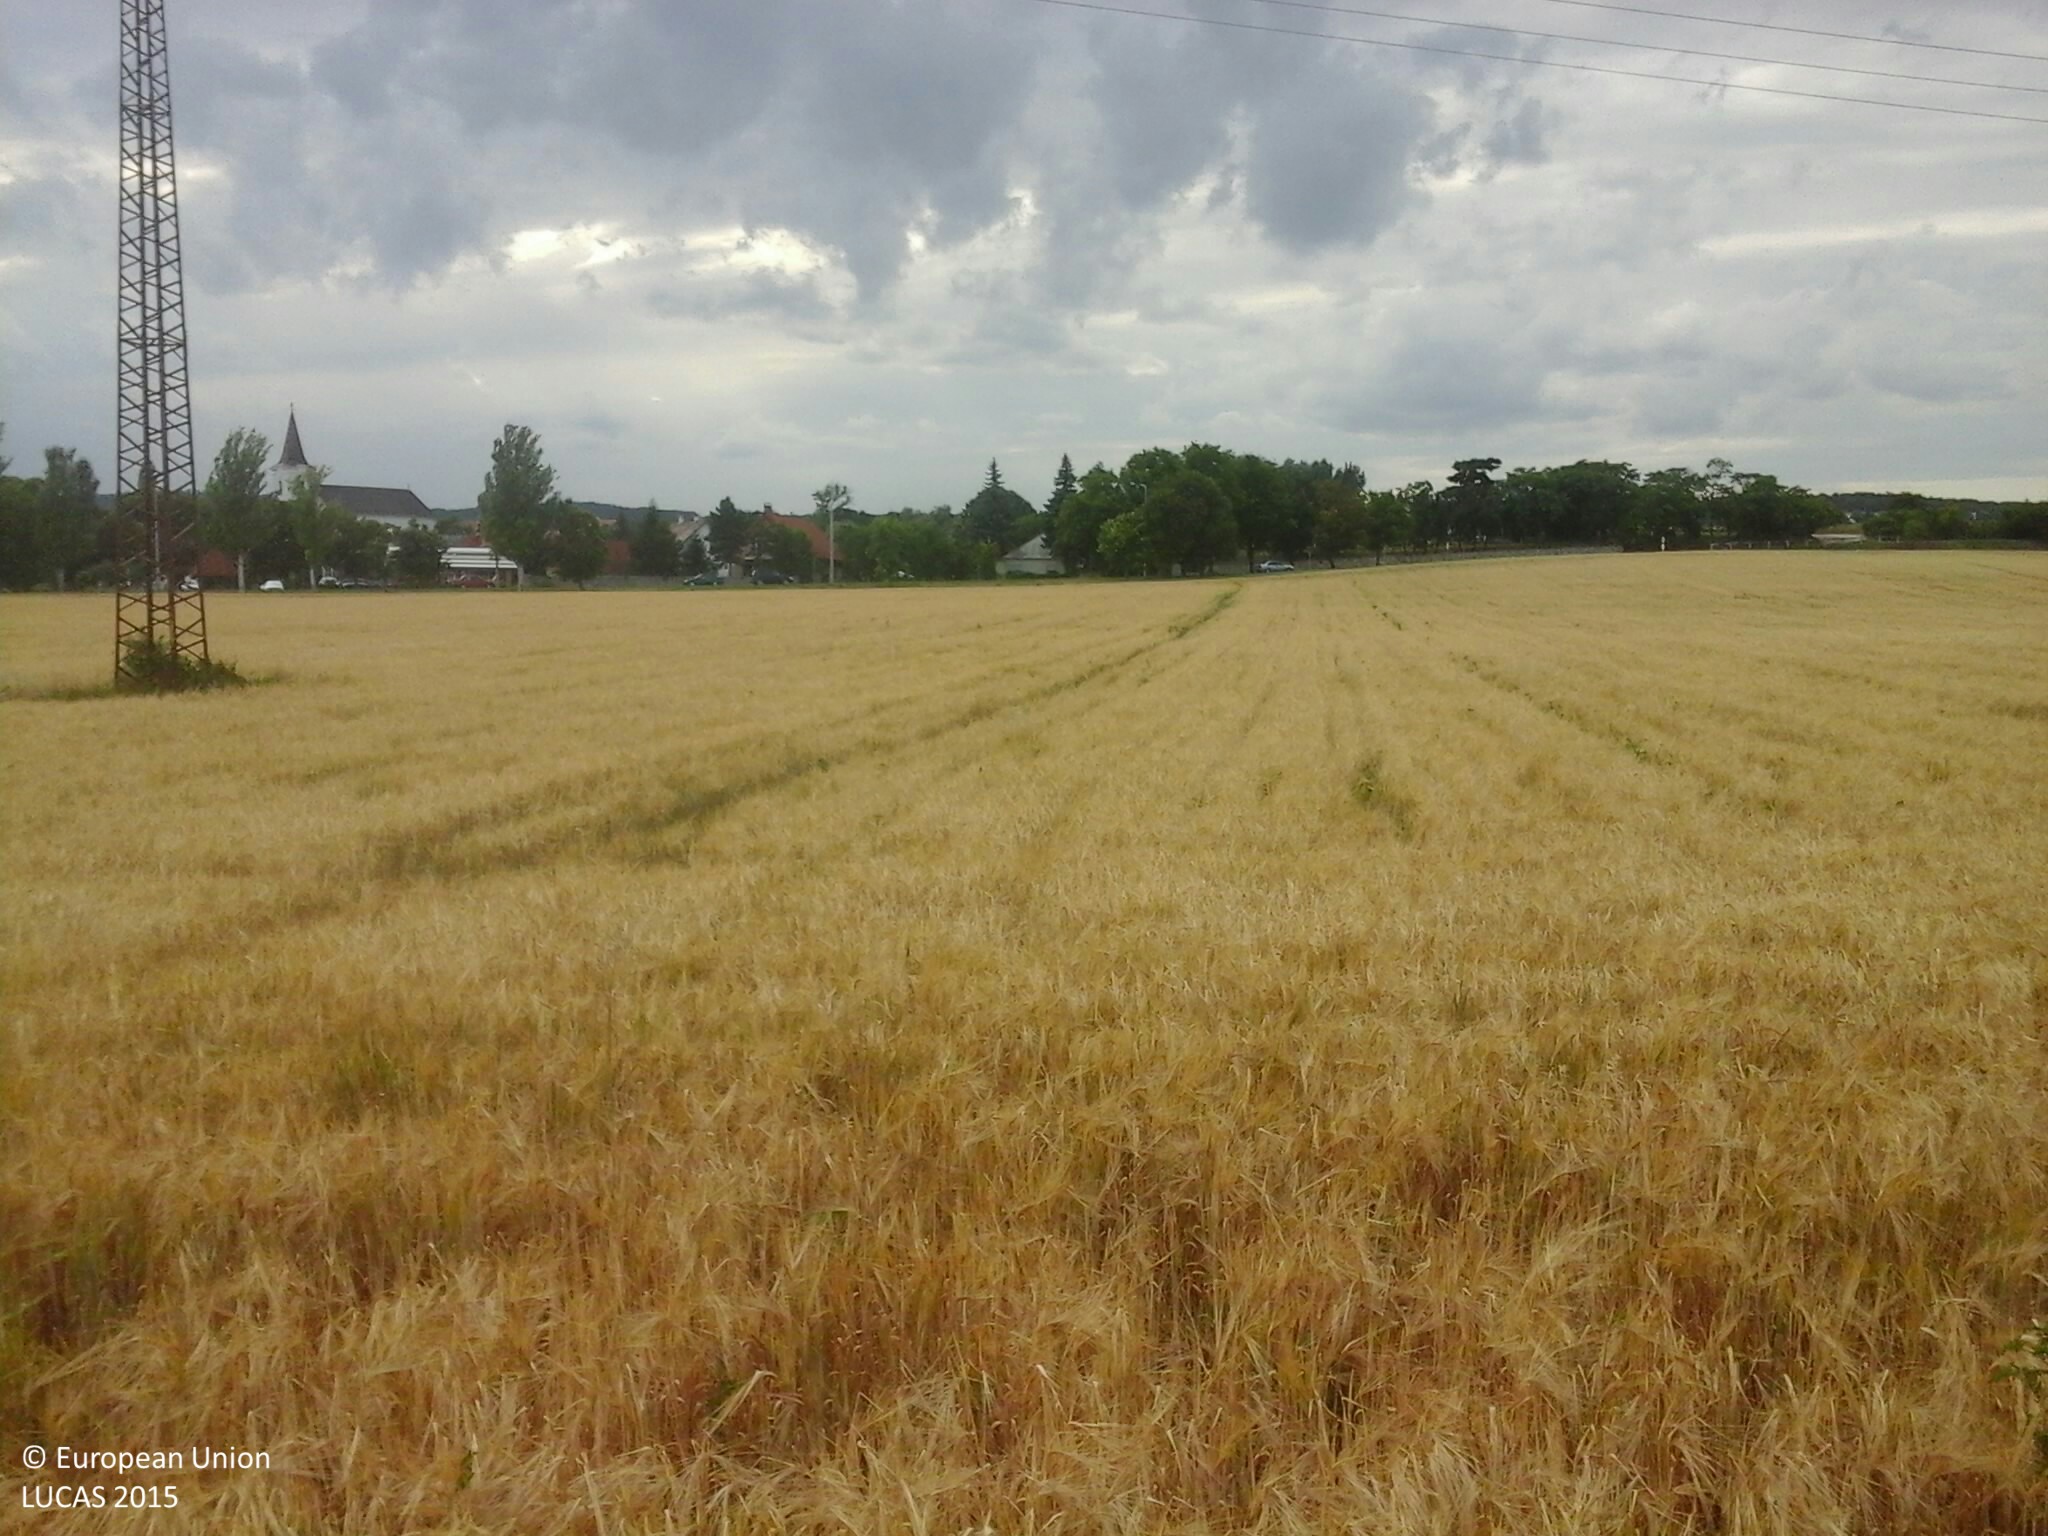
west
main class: Grassland
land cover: Grassland without tree/shrub cover
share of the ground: > 75 %
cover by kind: herbaceous plants 100 %
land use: Agriculture (excluding fallow land and kitchen gardens)
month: July
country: HU
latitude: 46.9148
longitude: 17.8204
